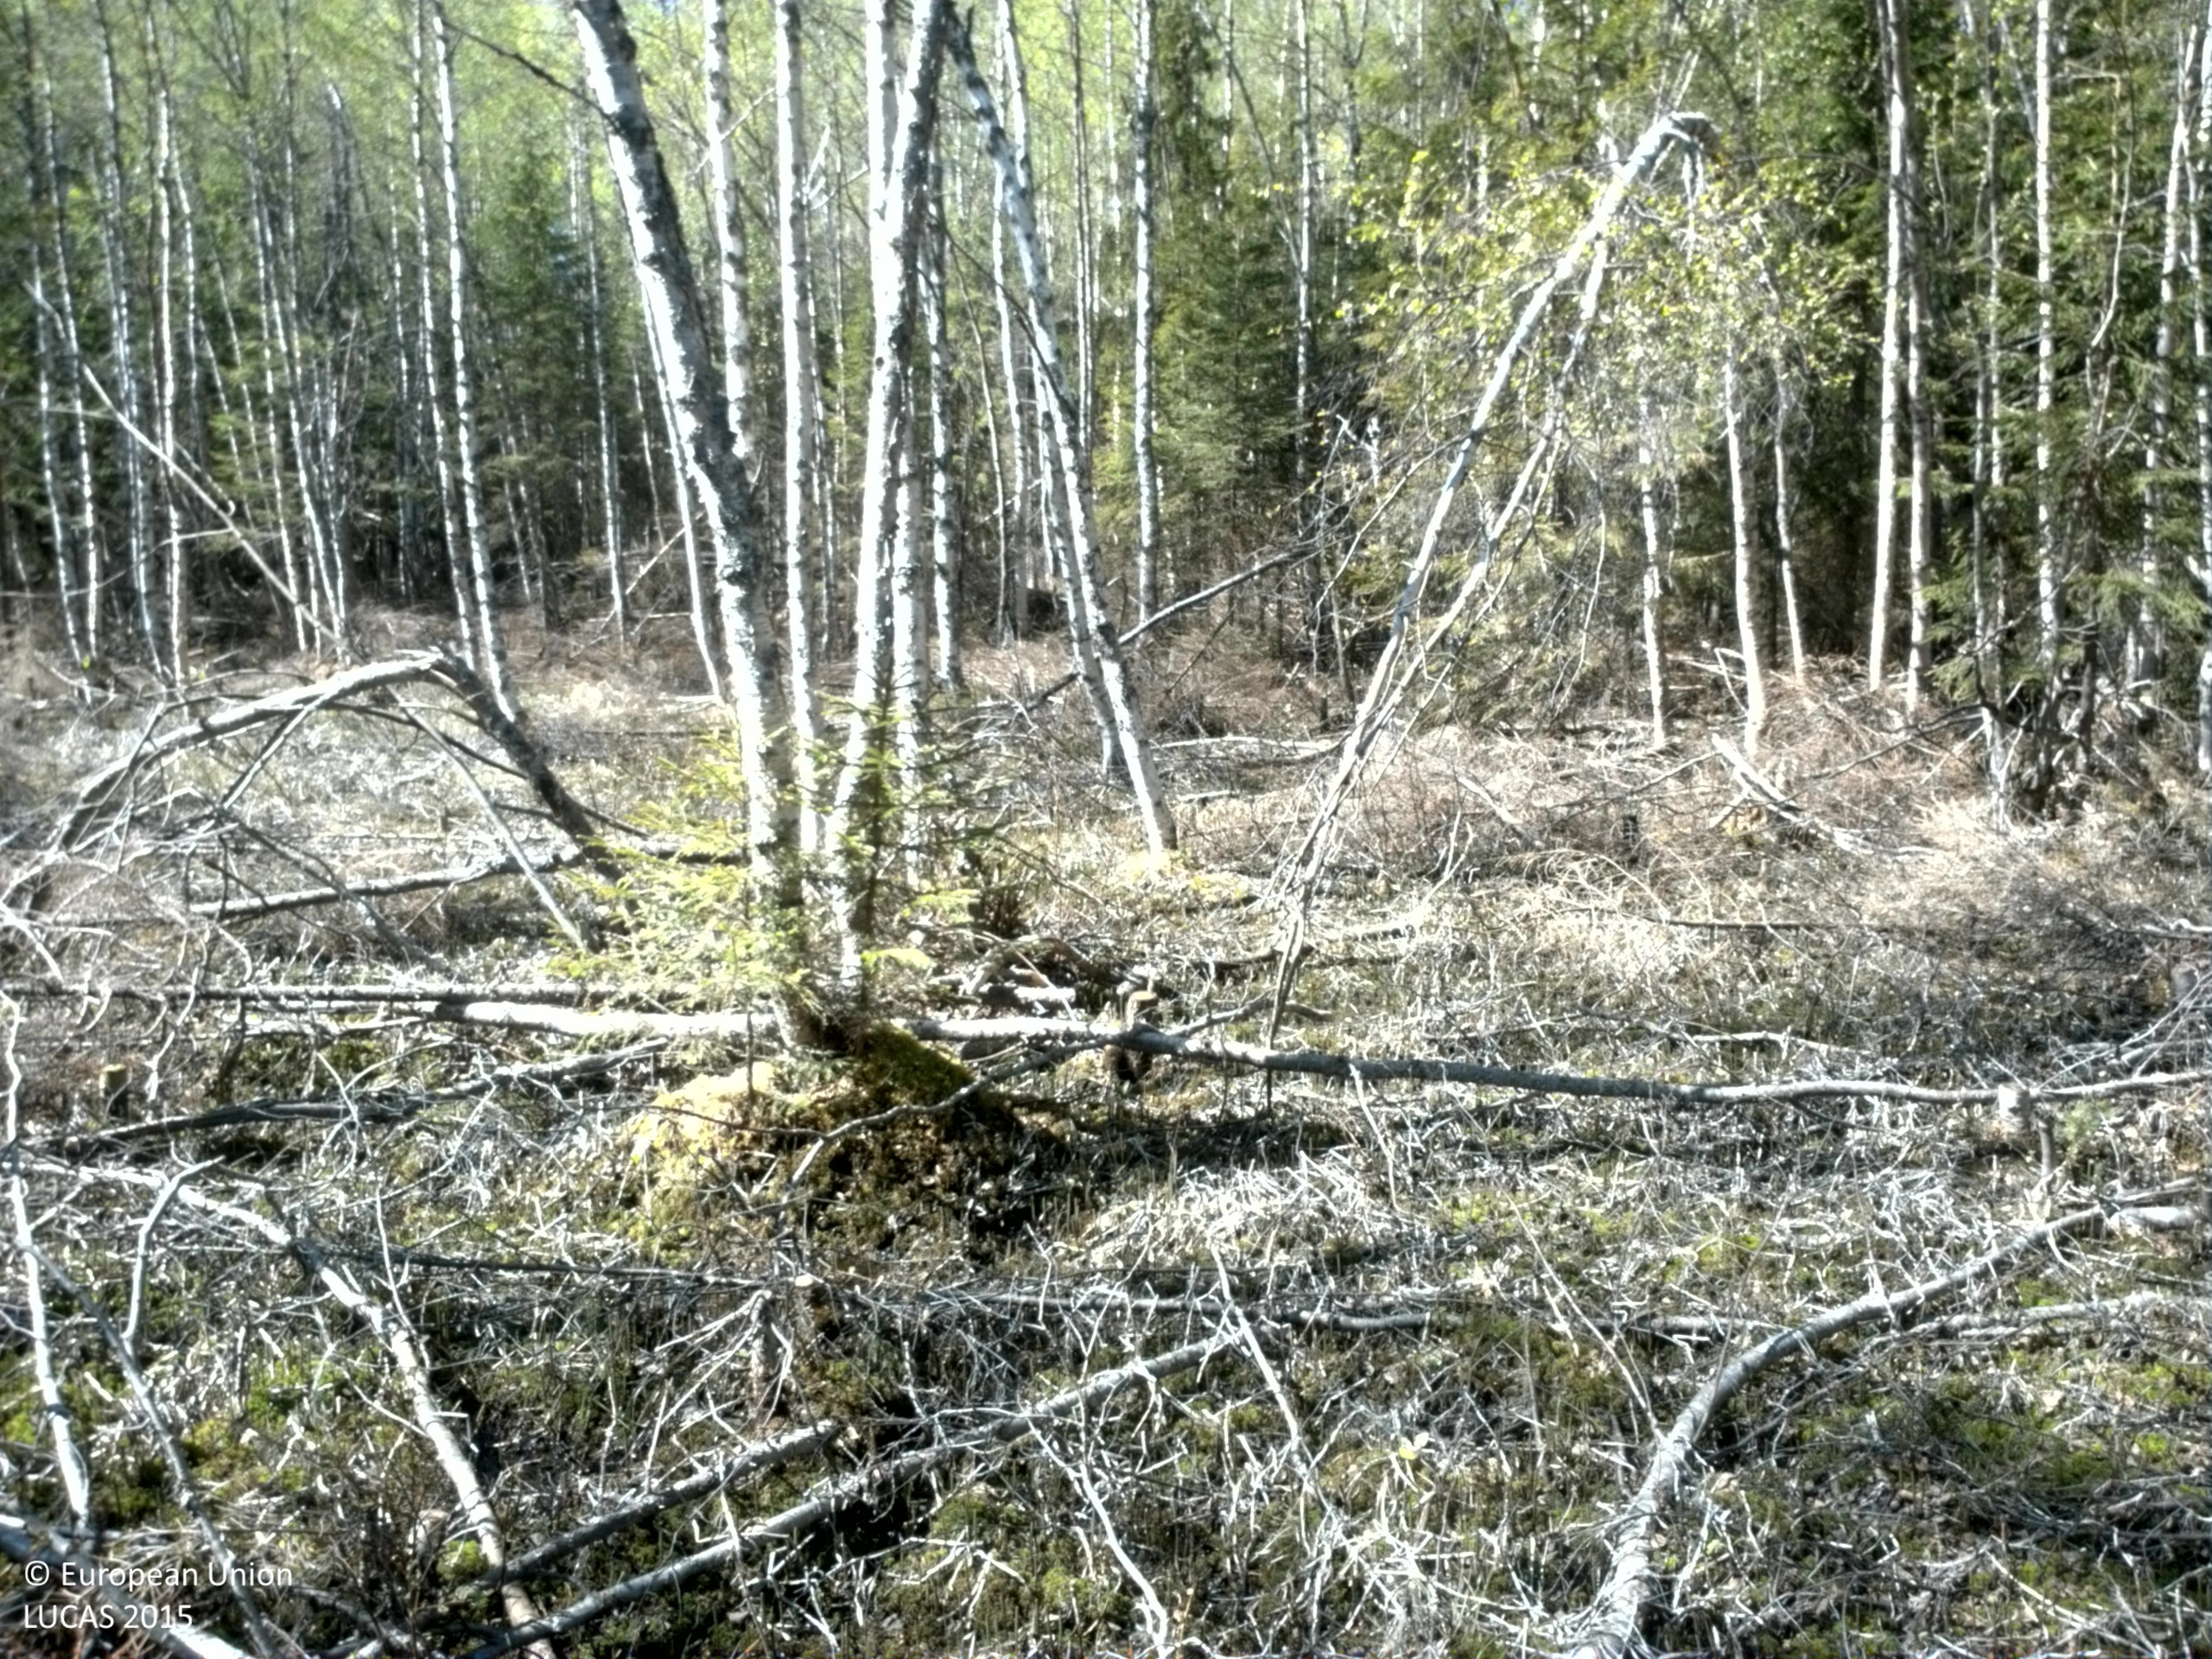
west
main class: Woodland
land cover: Spruce dominated mixed woodland
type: boreal forest
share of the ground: 10 - 25 %
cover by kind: shrubs 20 %, unconsolidated bare surface 20 %, lichens and mosses 15 %, broadleaved forest trees 10 %, coniferous forest trees 5 %
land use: Forestry
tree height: > 5 m
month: May
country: SE
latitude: 63.0690
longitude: 18.0324
